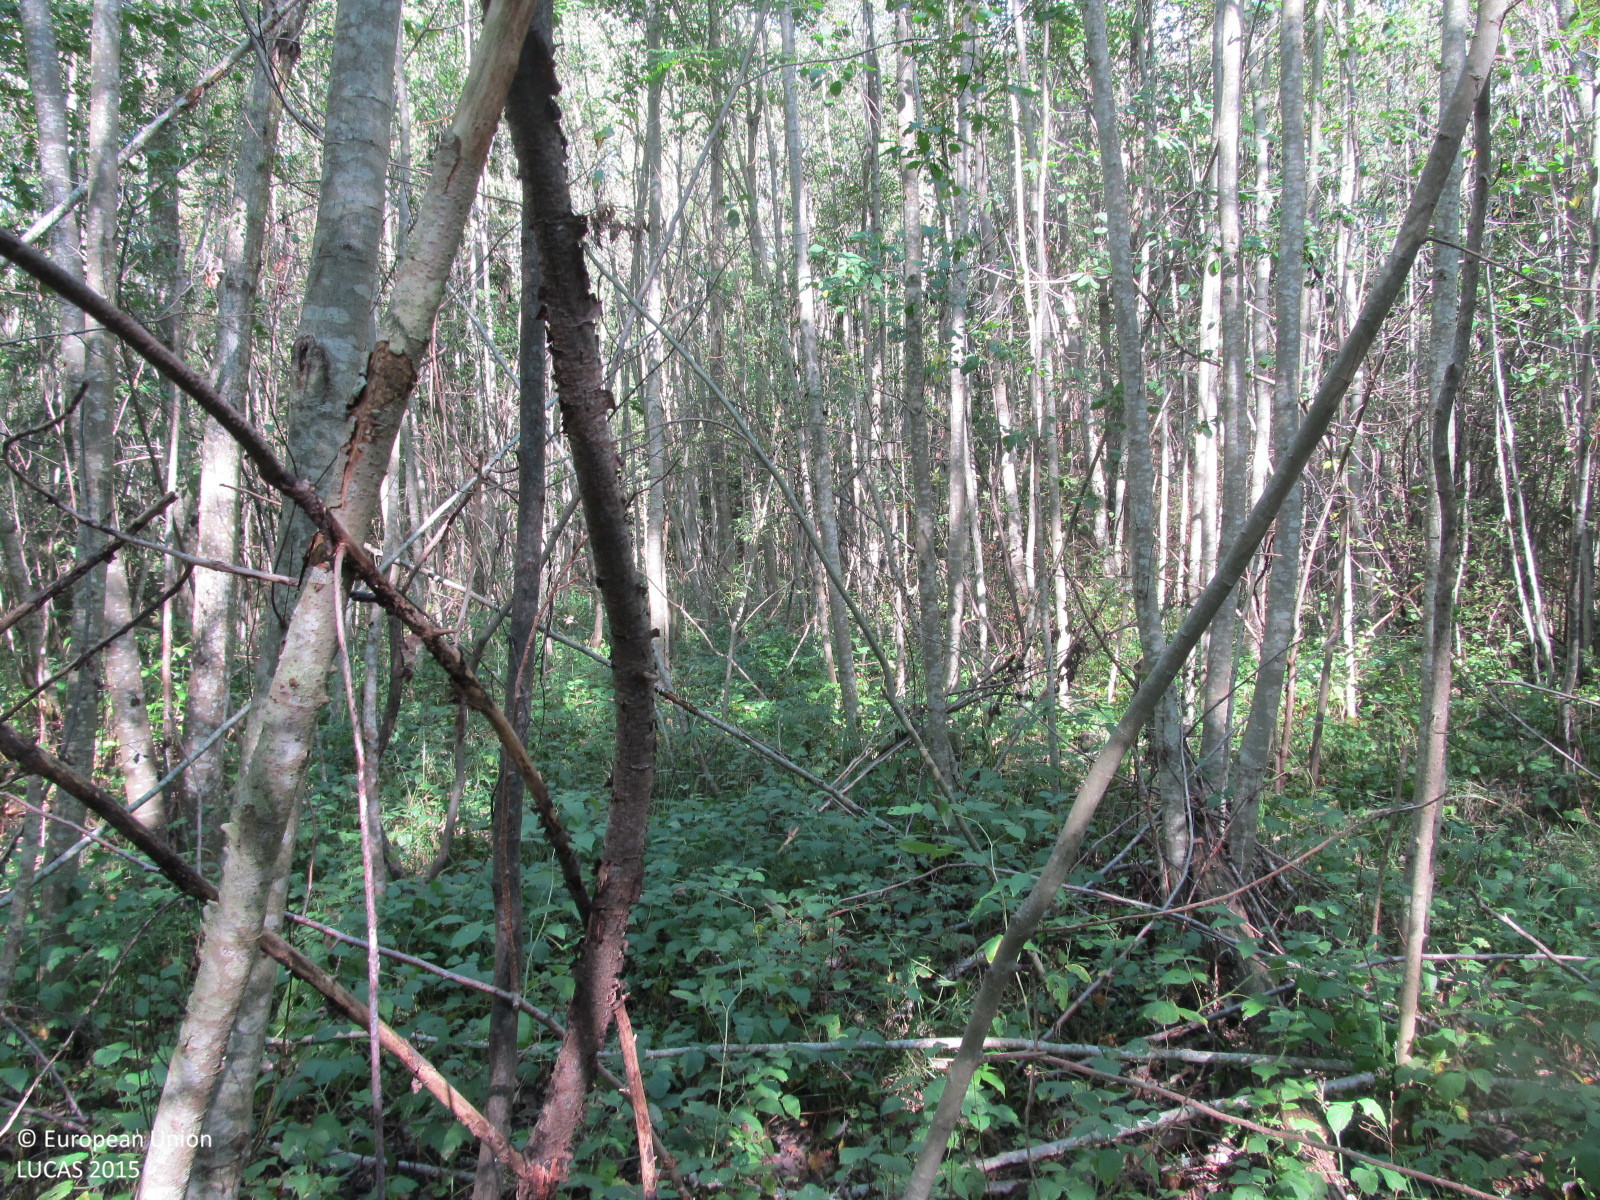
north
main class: Woodland
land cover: Broadleaved woodland
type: non-riverine alder, birch or aspen forest
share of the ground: > 75 %
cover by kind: broadleaved forest trees 85 %, shrubs 5 %, herbaceous plants 5 %, unconsolidated bare surface 5 %
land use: Forestry
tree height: > 5 m
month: September
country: LT
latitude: 56.0868
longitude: 23.3648
